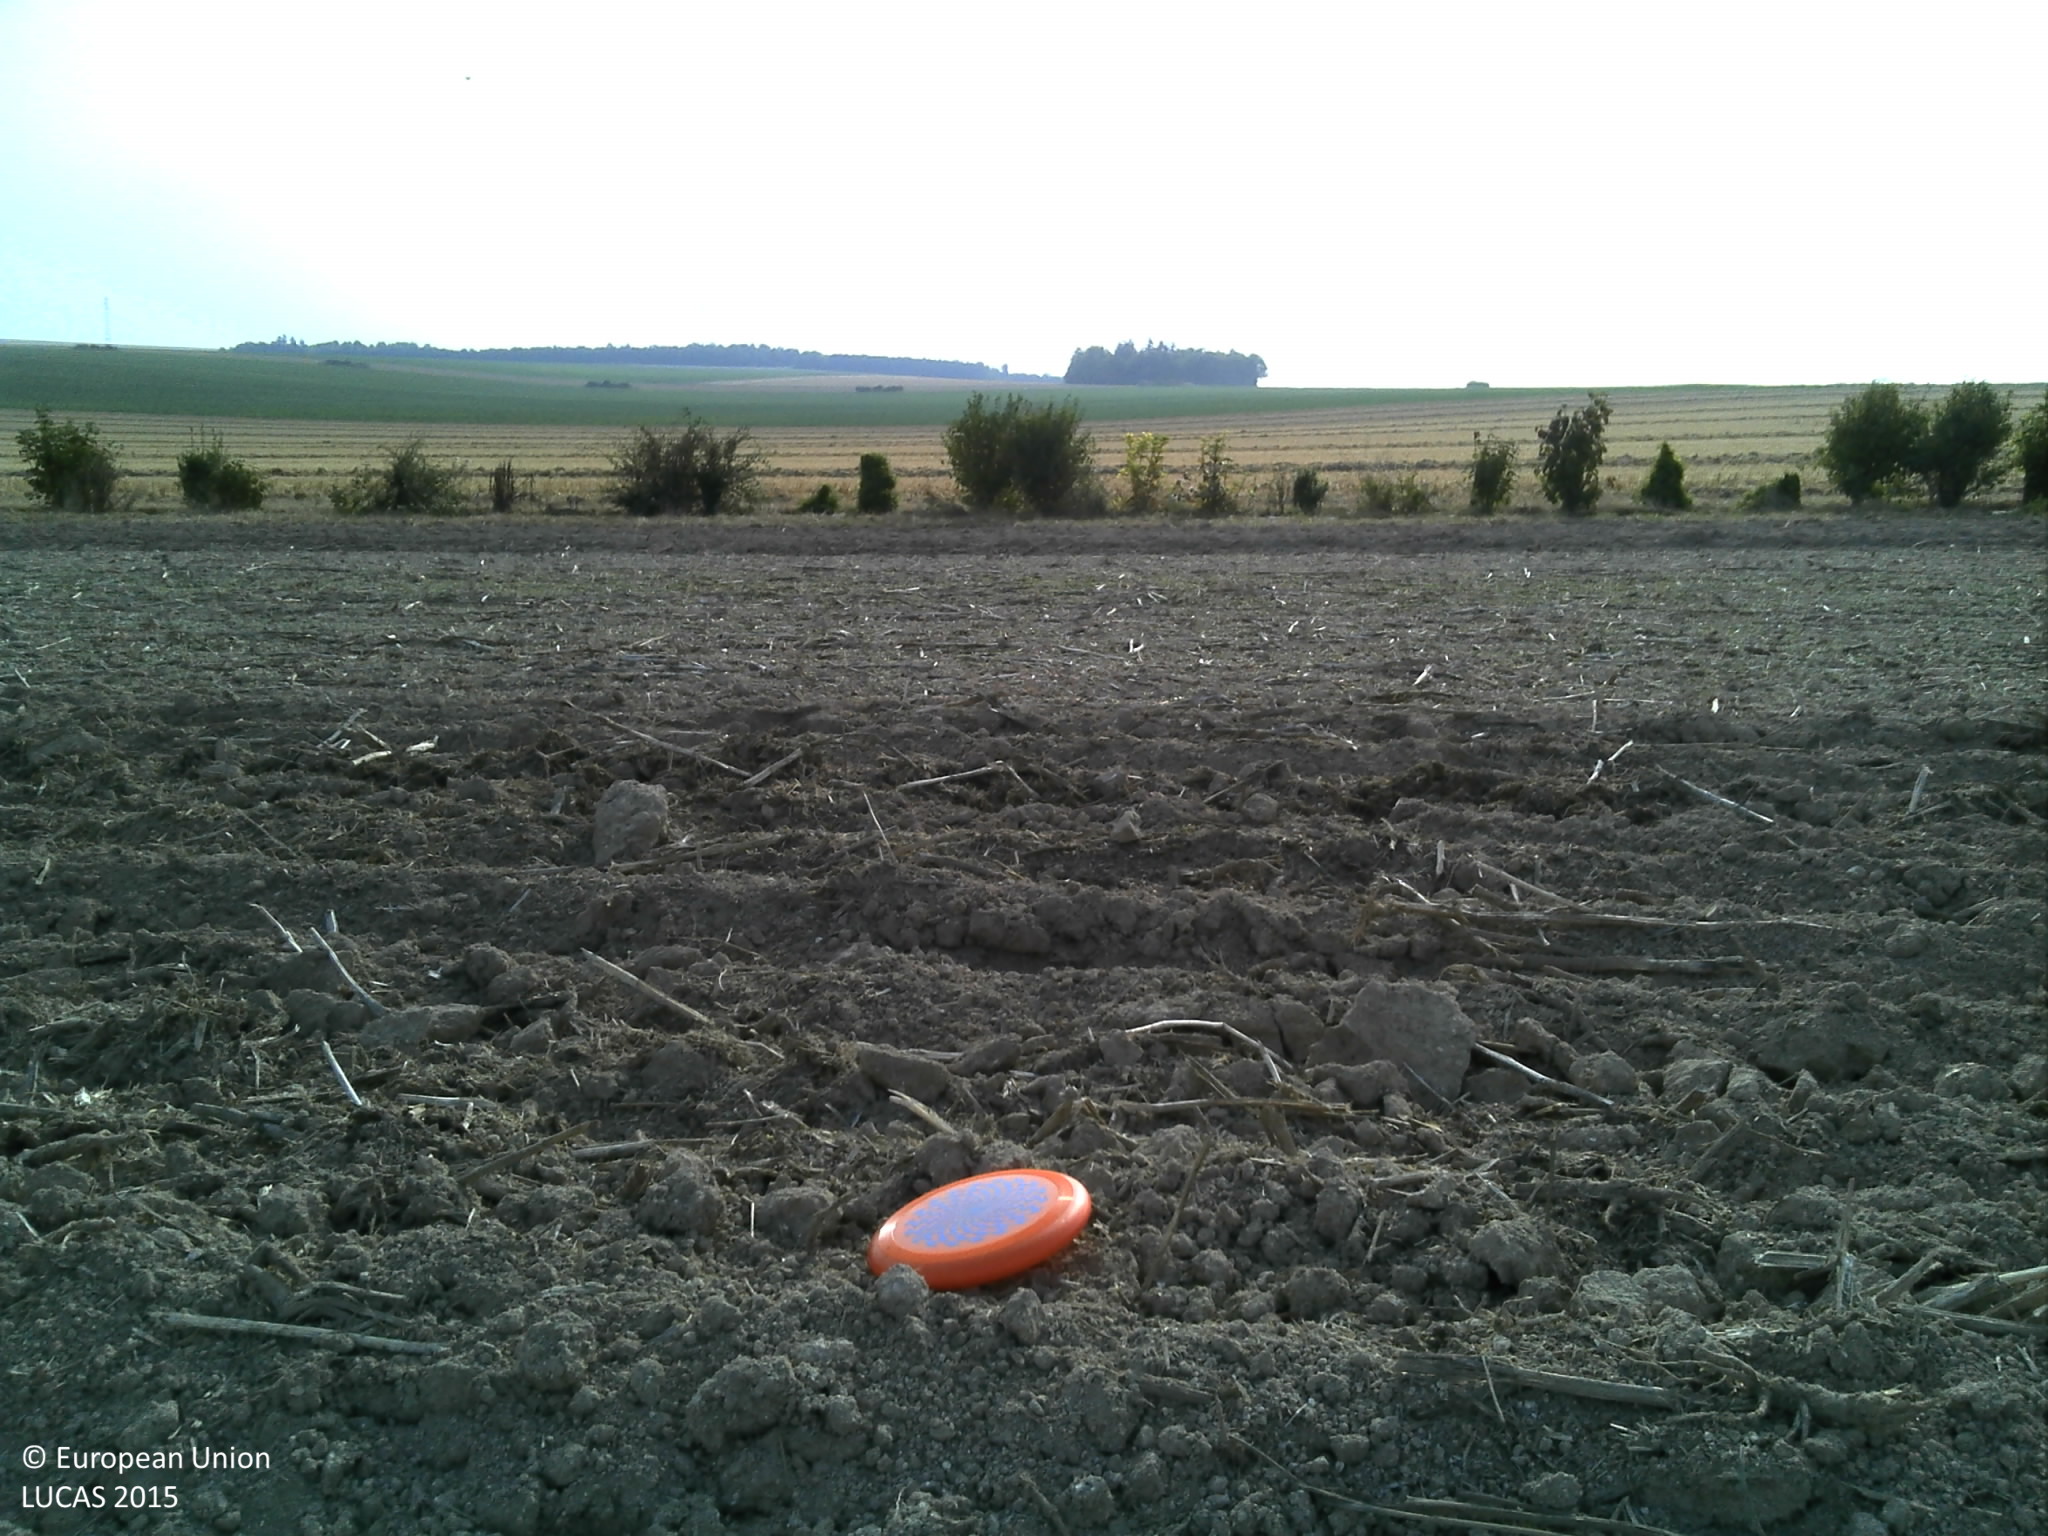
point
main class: Cropland
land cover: Rape and turnip rape
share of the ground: > 75 %
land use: Agriculture (excluding fallow land and kitchen gardens)
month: August
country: FR
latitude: 49.0080
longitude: 4.5420
